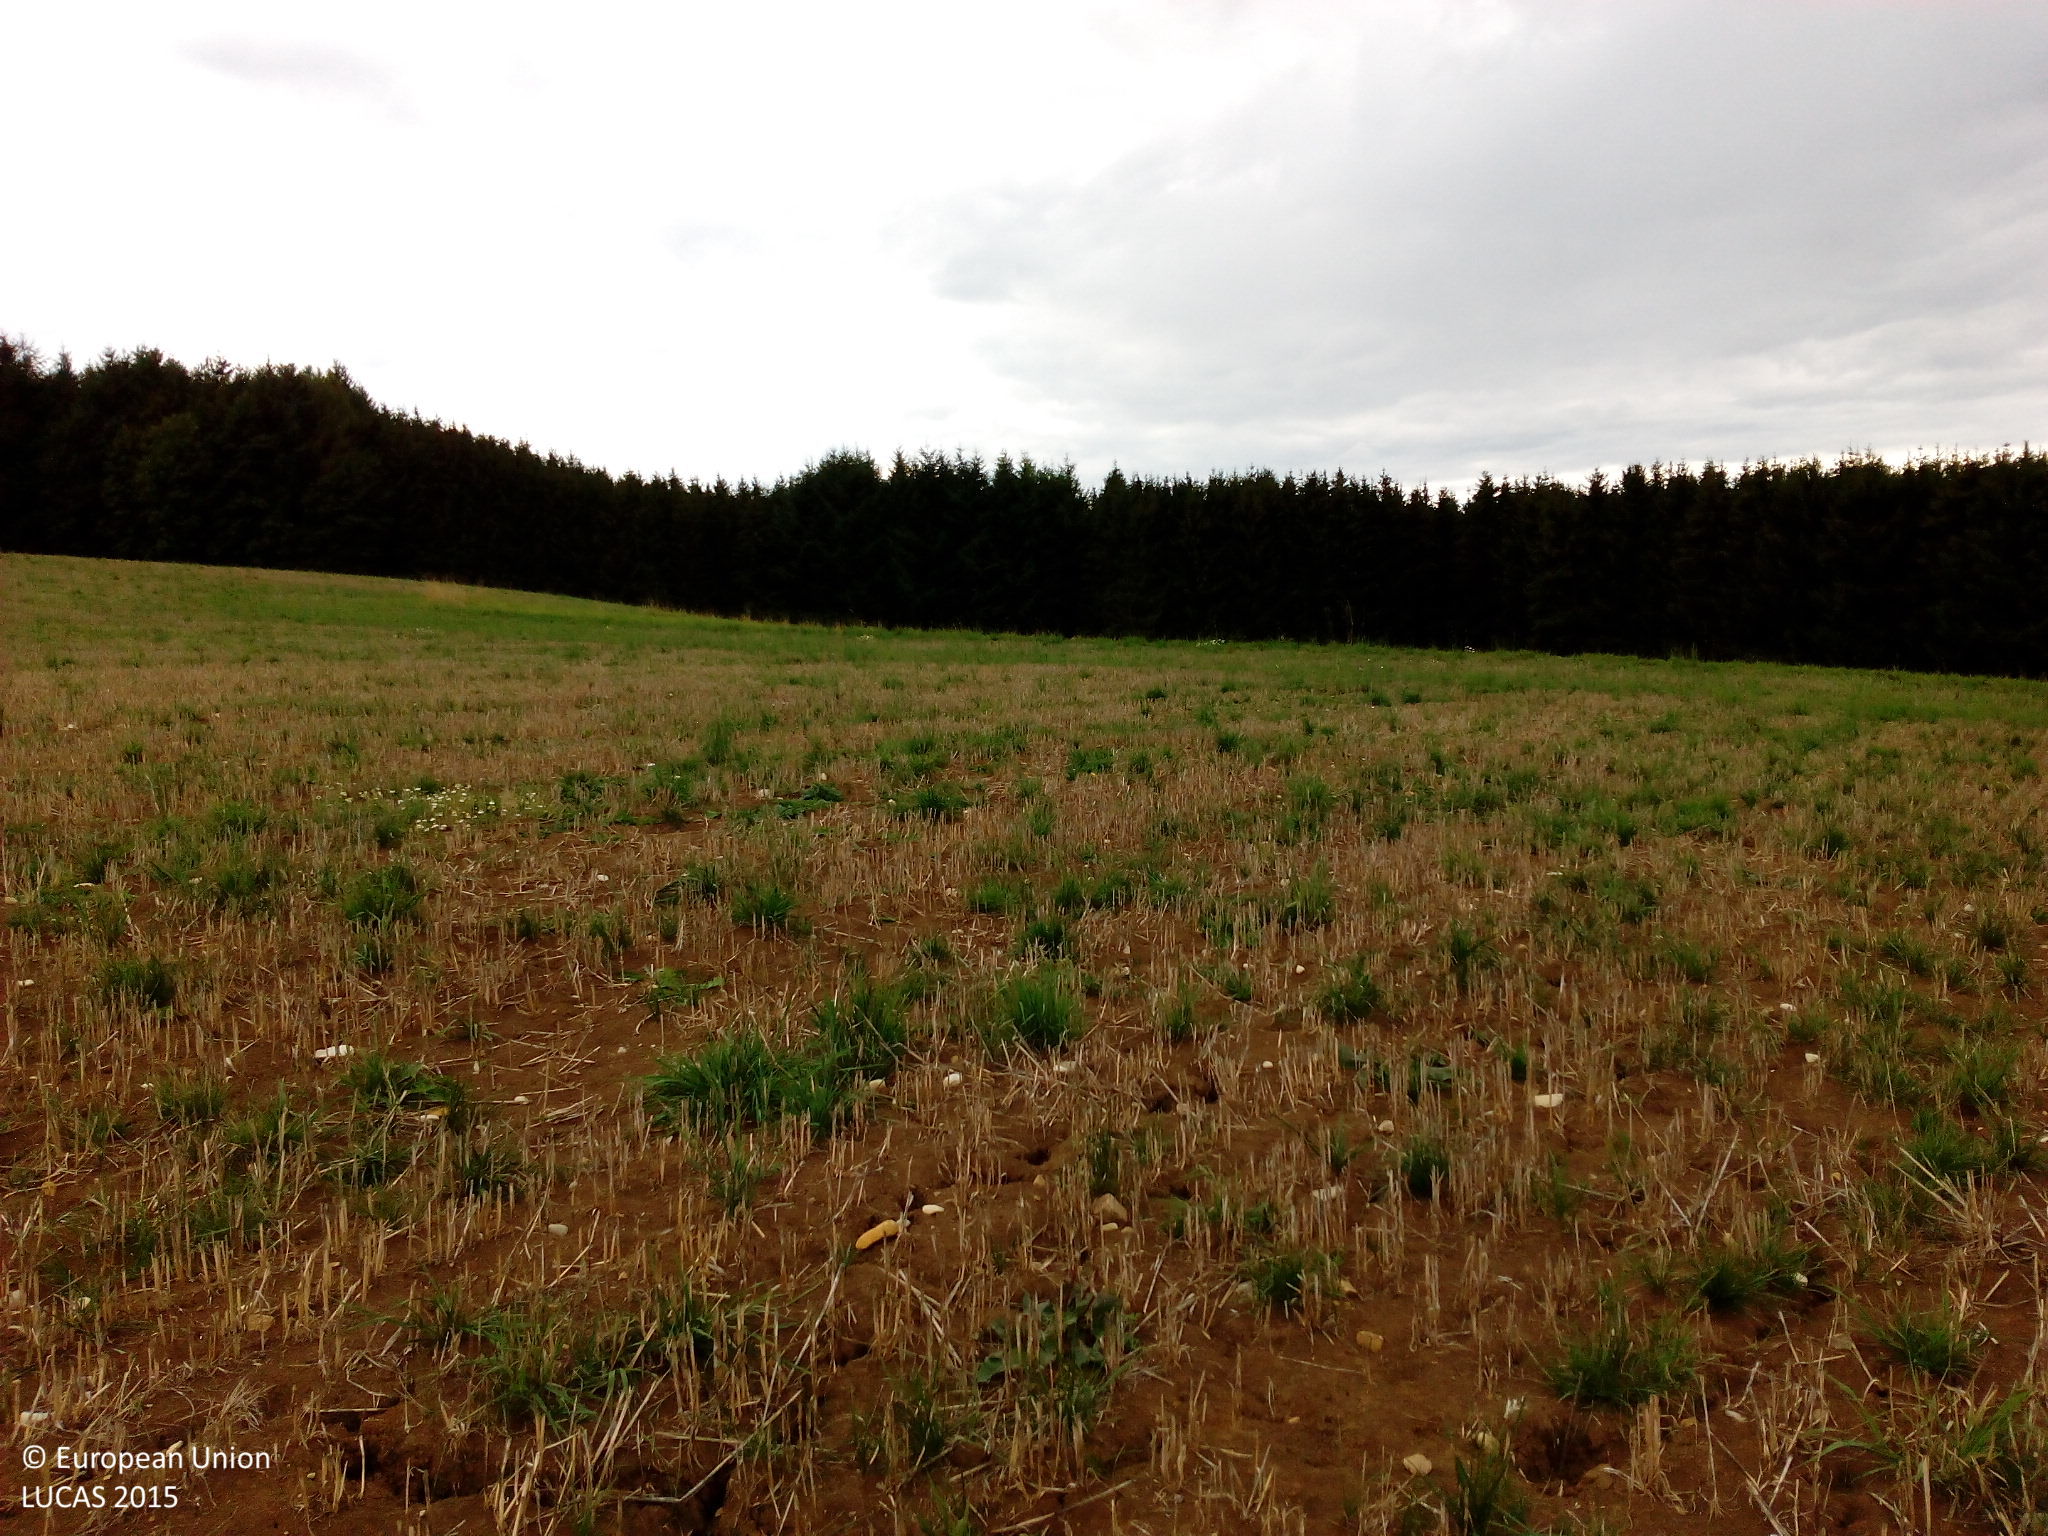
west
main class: Grassland
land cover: Spontaneously vegetated surfaces
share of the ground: 10 - 25 %
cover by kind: unconsolidated bare surface 70 %, herbaceous plants 25 %
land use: Agriculture (excluding fallow land and kitchen gardens)
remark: Harvested field
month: September
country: DE
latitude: 47.8919
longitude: 8.7035
